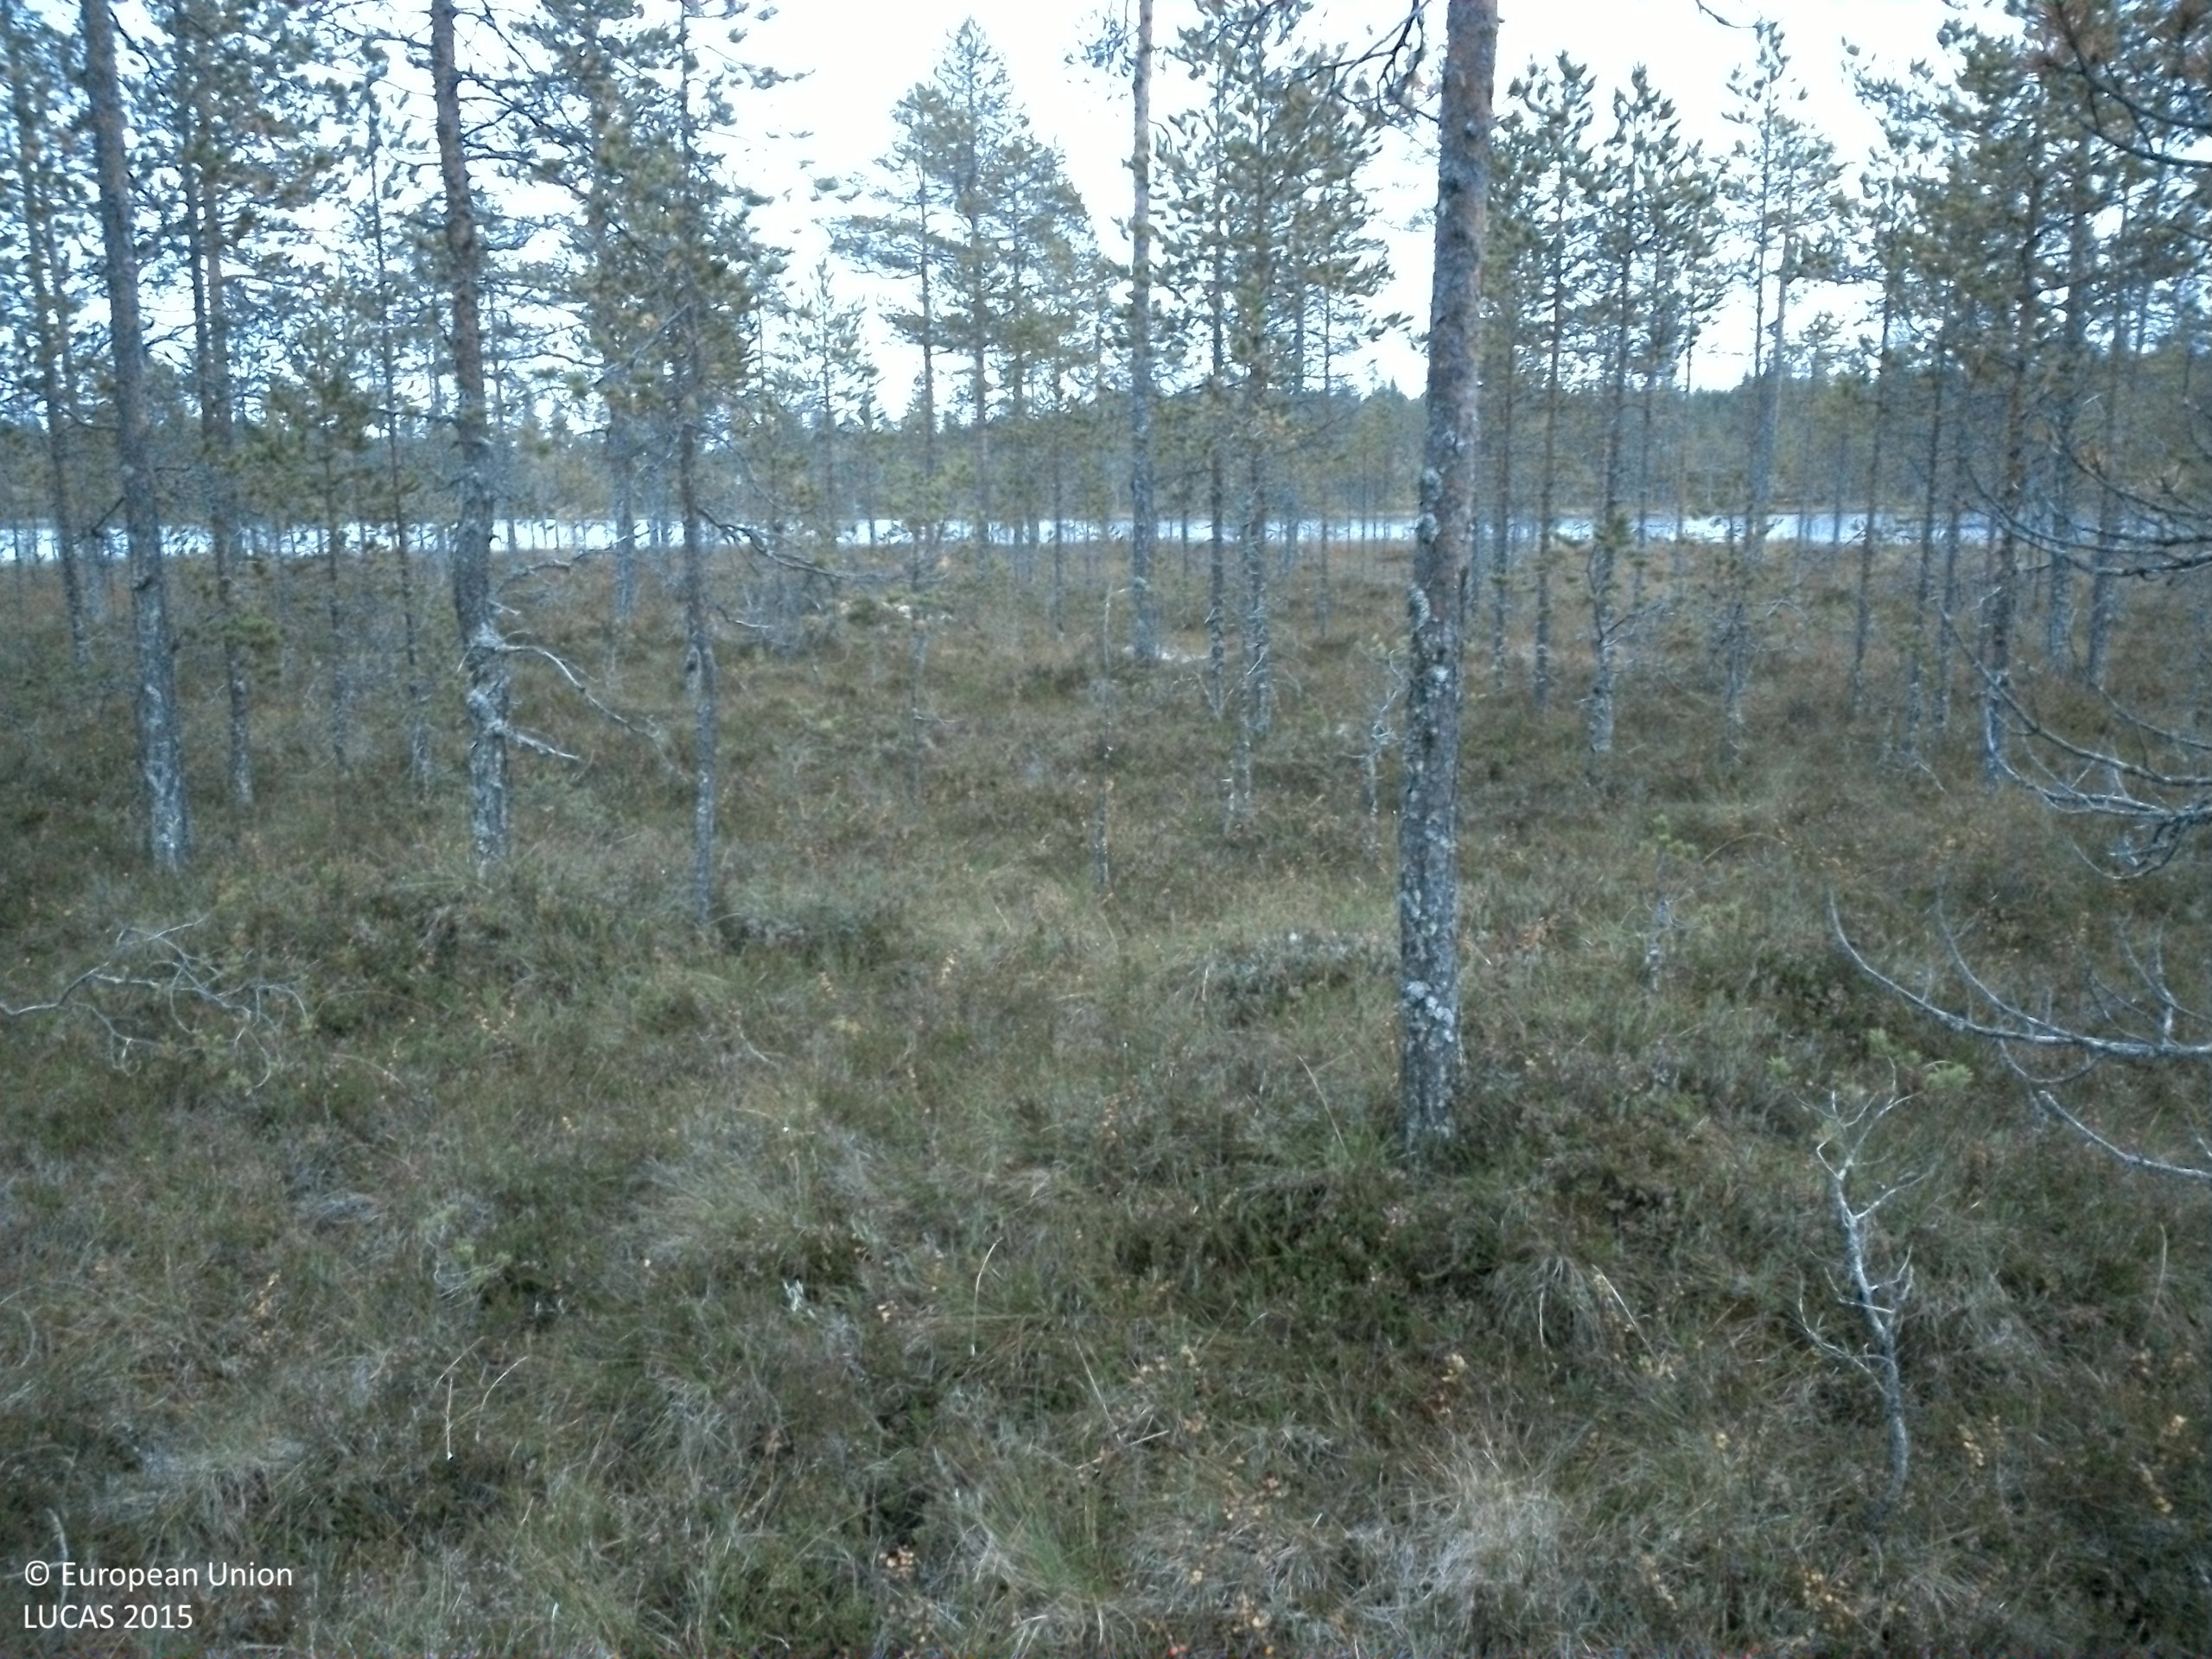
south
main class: Woodland
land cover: Pine dominated coniferous woodland
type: boreal forest
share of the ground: 10 - 25 %
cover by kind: shrubs 40 %, lichens and mosses 40 %, coniferous forest trees 20 %
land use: Forestry
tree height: > 5 m
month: September
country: SE
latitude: 61.6293
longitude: 14.9078
